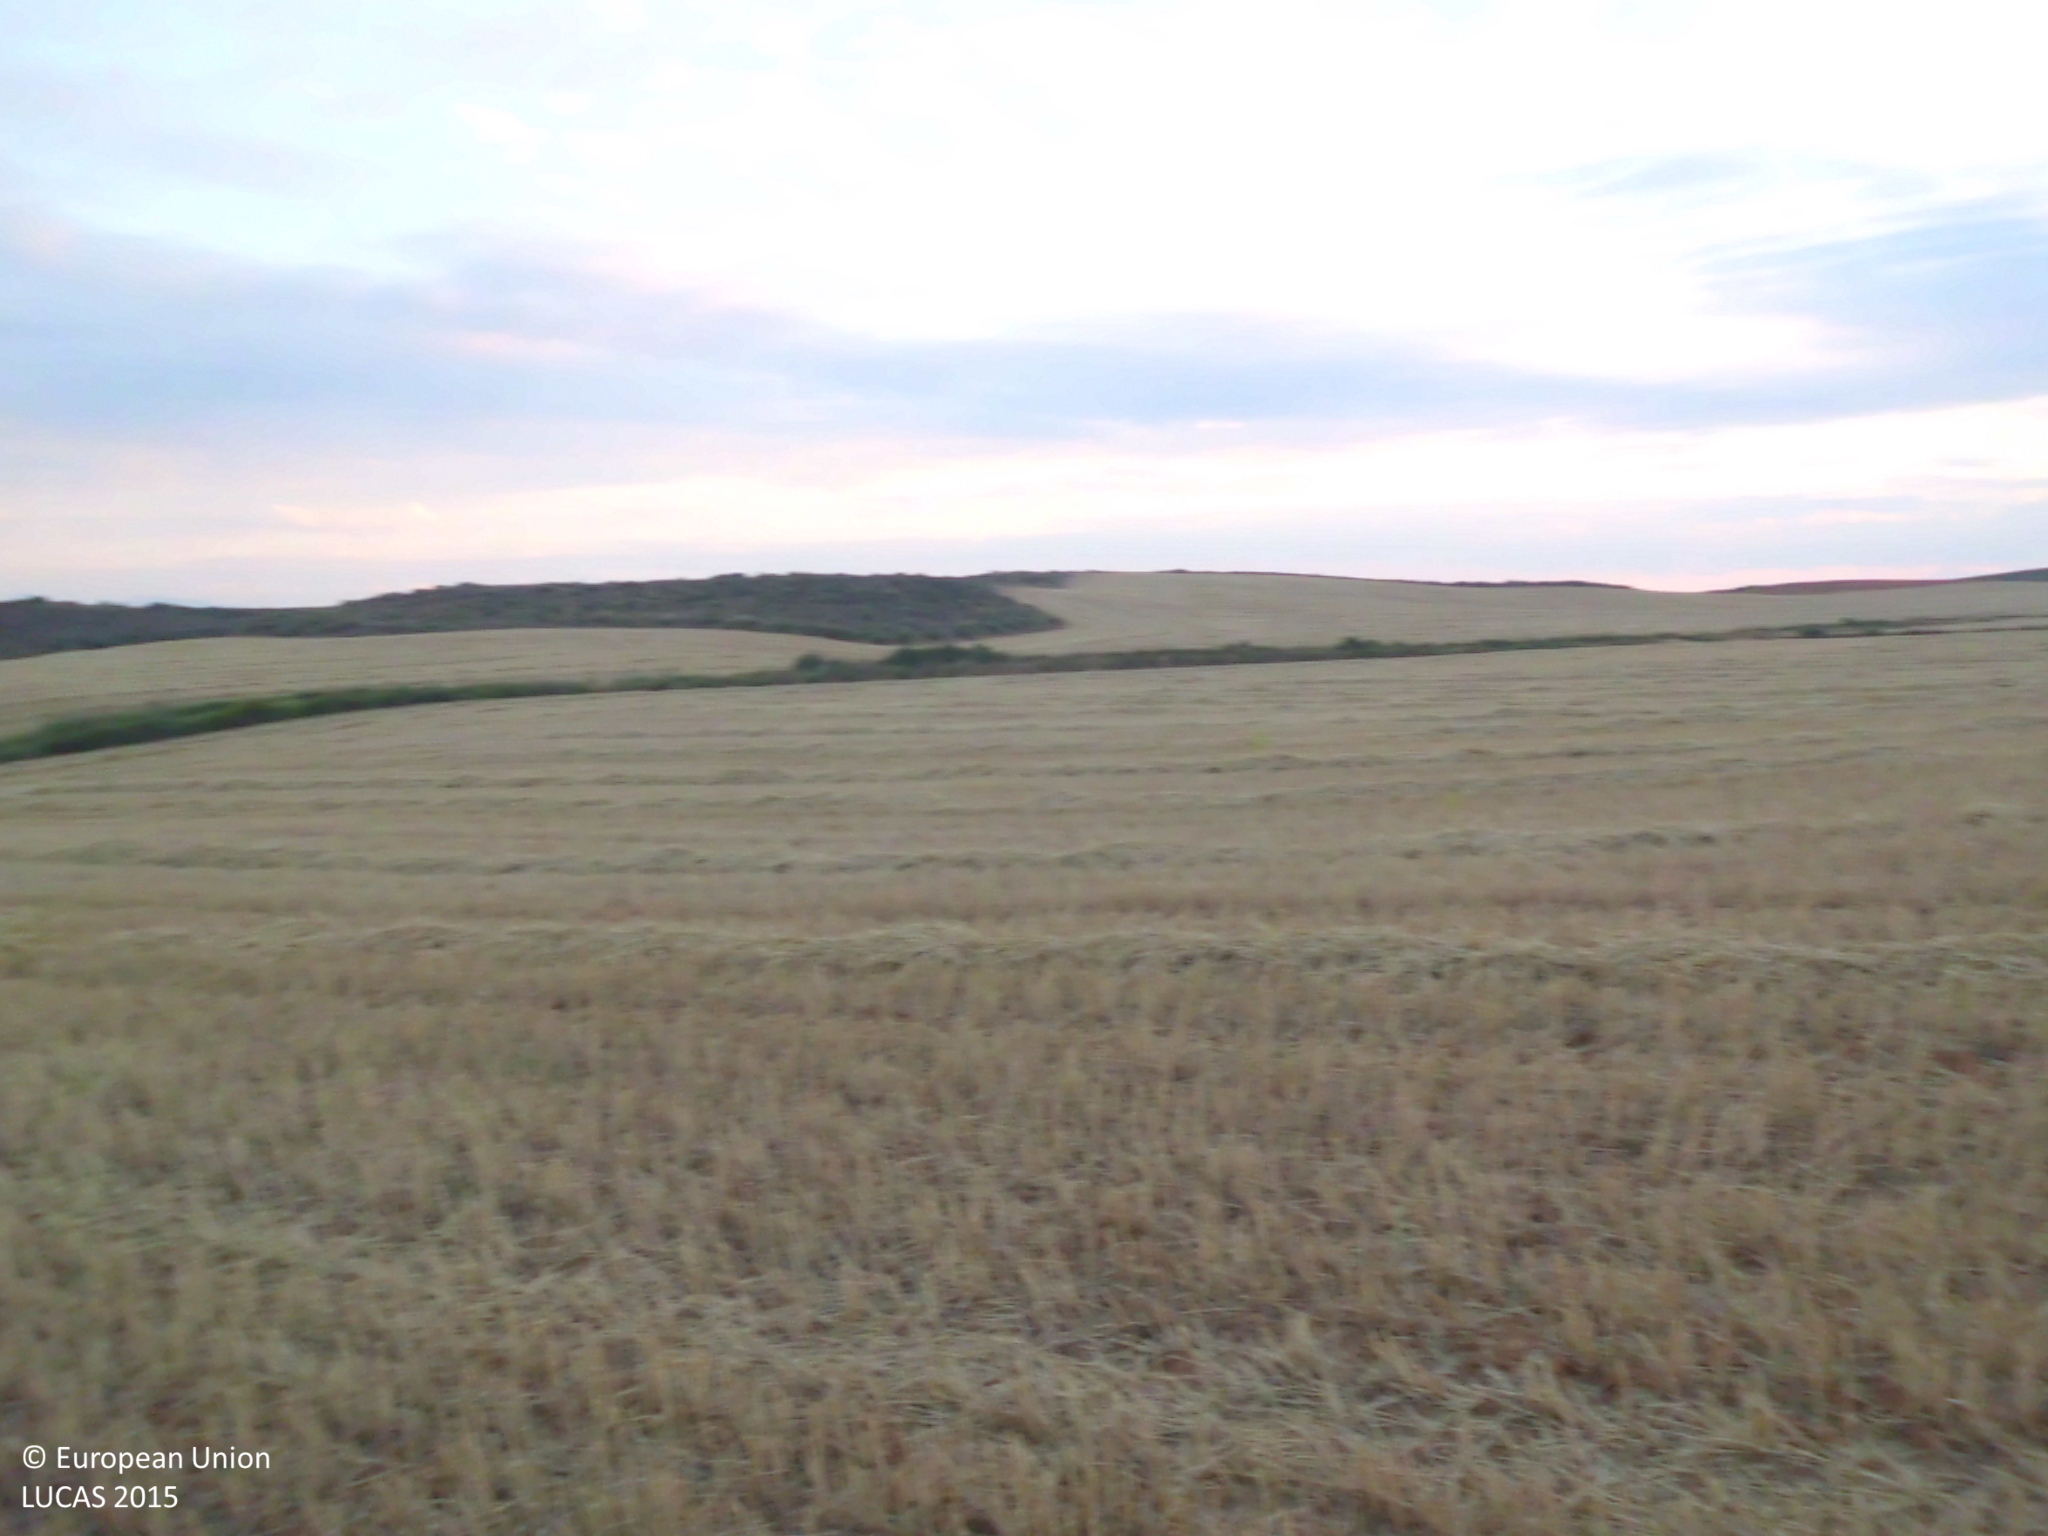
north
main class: Cropland
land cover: Barley
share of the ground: < 10 %
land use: Agriculture (excluding fallow land and kitchen gardens)
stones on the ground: < 10 %
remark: Harvested field
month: July
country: ES
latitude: 42.5905
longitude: -4.3932
